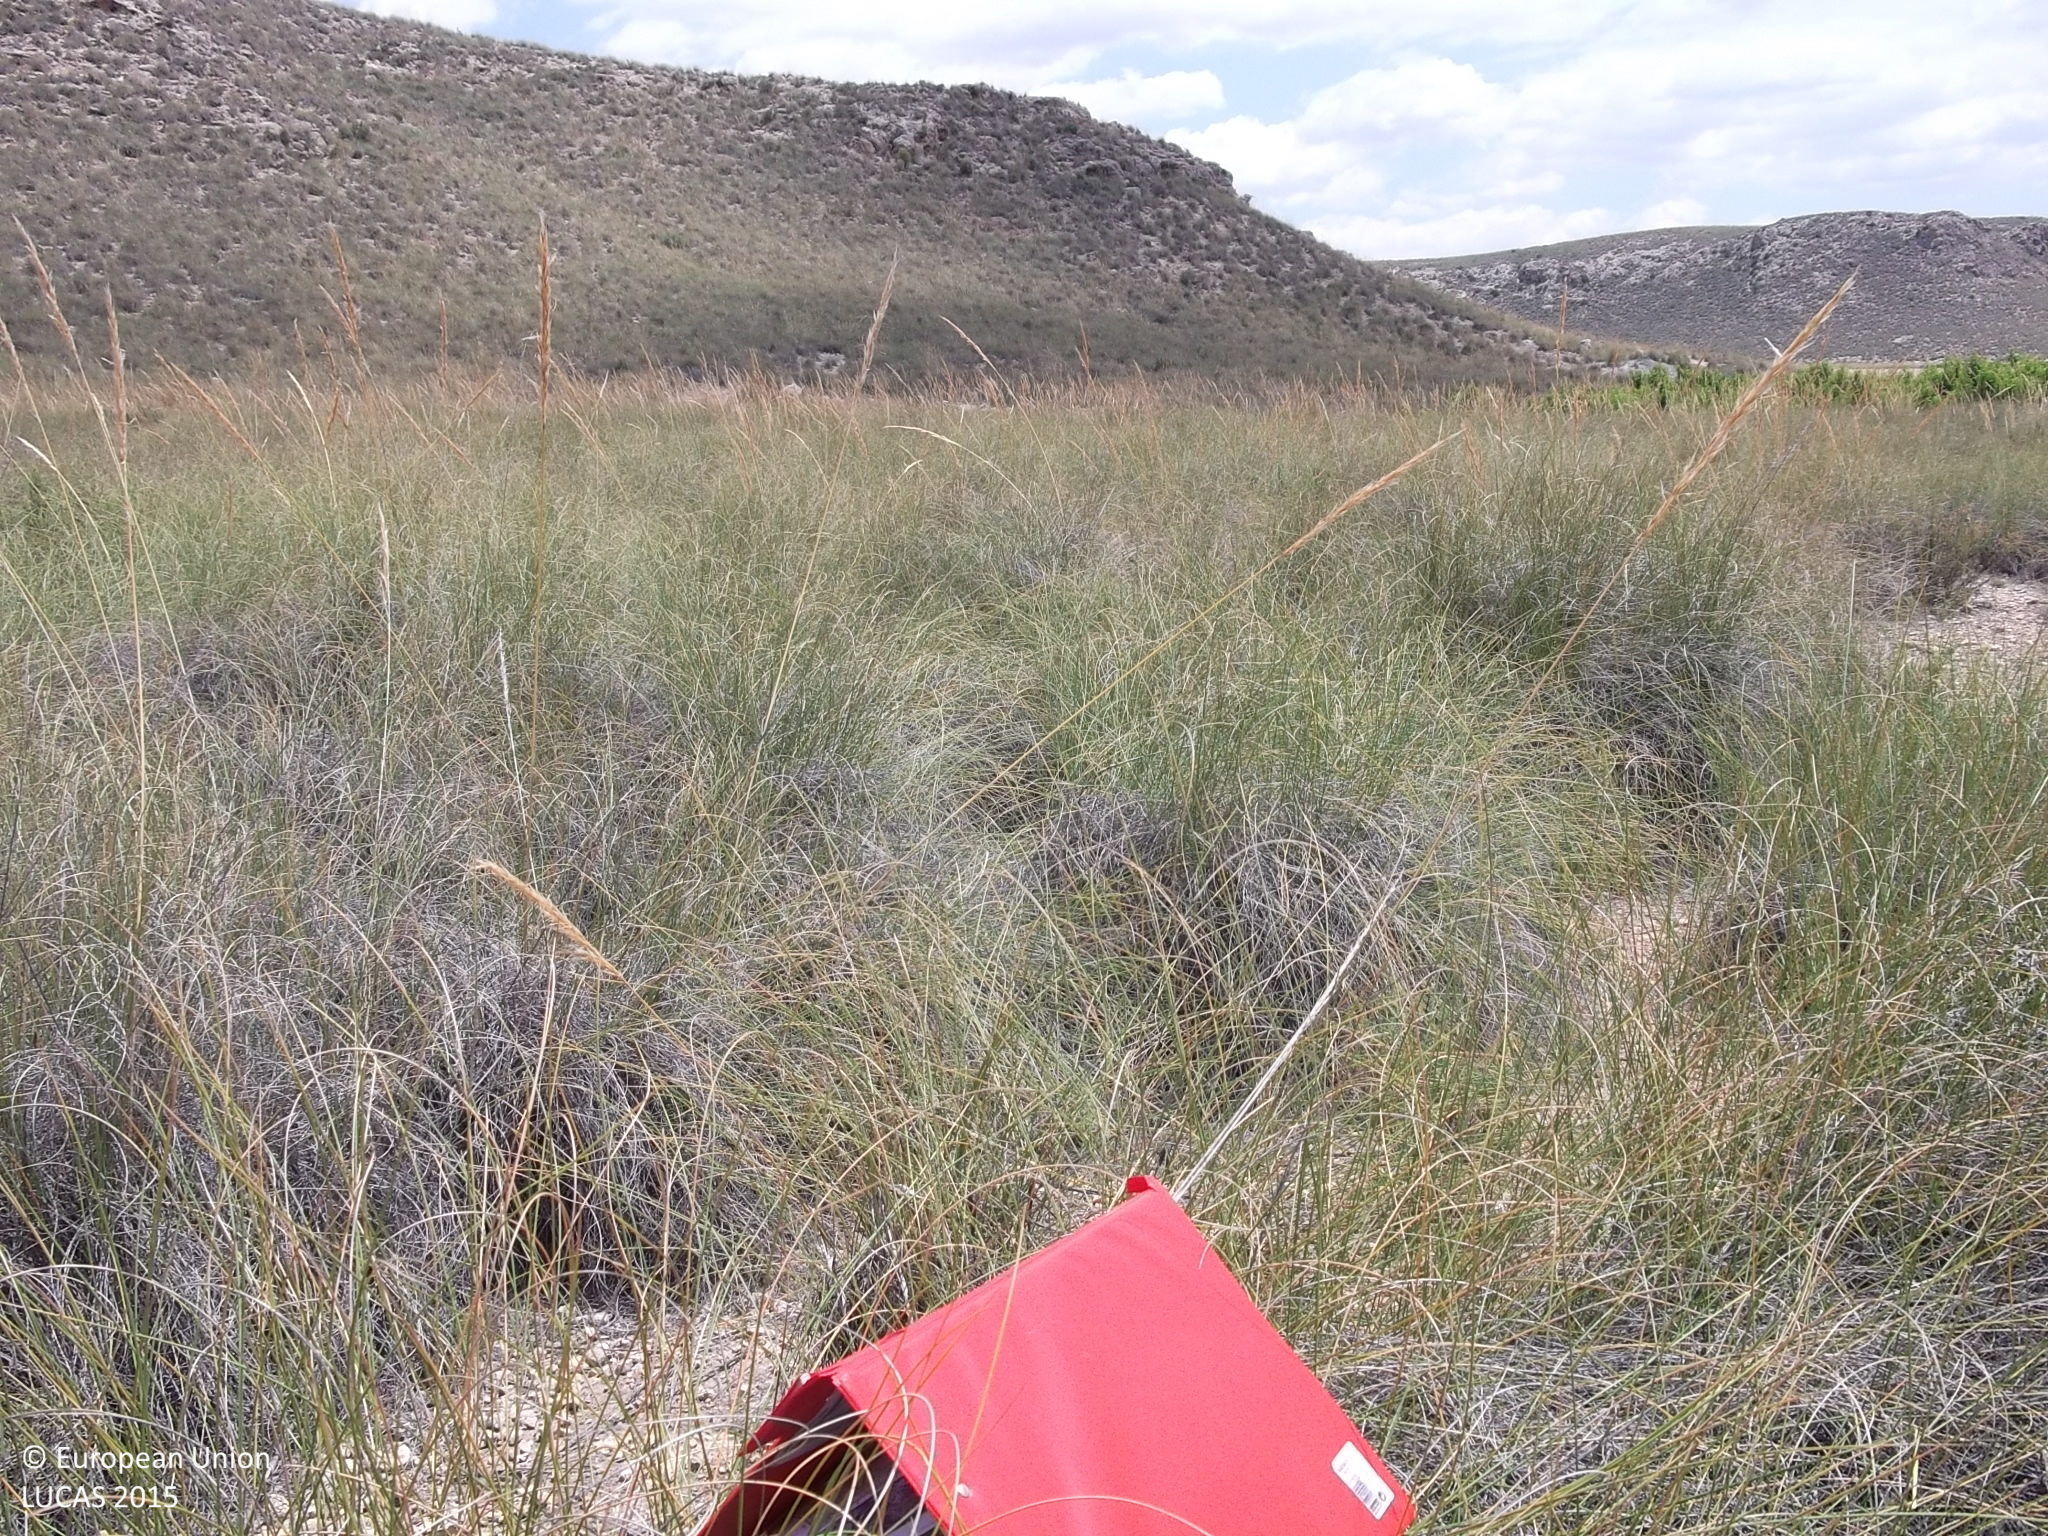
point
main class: Shrubland
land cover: Shrubland without tree cover
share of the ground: 25 - 50 %
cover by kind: shrubs 40 %, herbaceous plants 40 %, consolidated bare surface 20 %
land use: Semi-natural and natural areas not in use
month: May
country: ES
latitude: 38.3888
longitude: -1.4506
